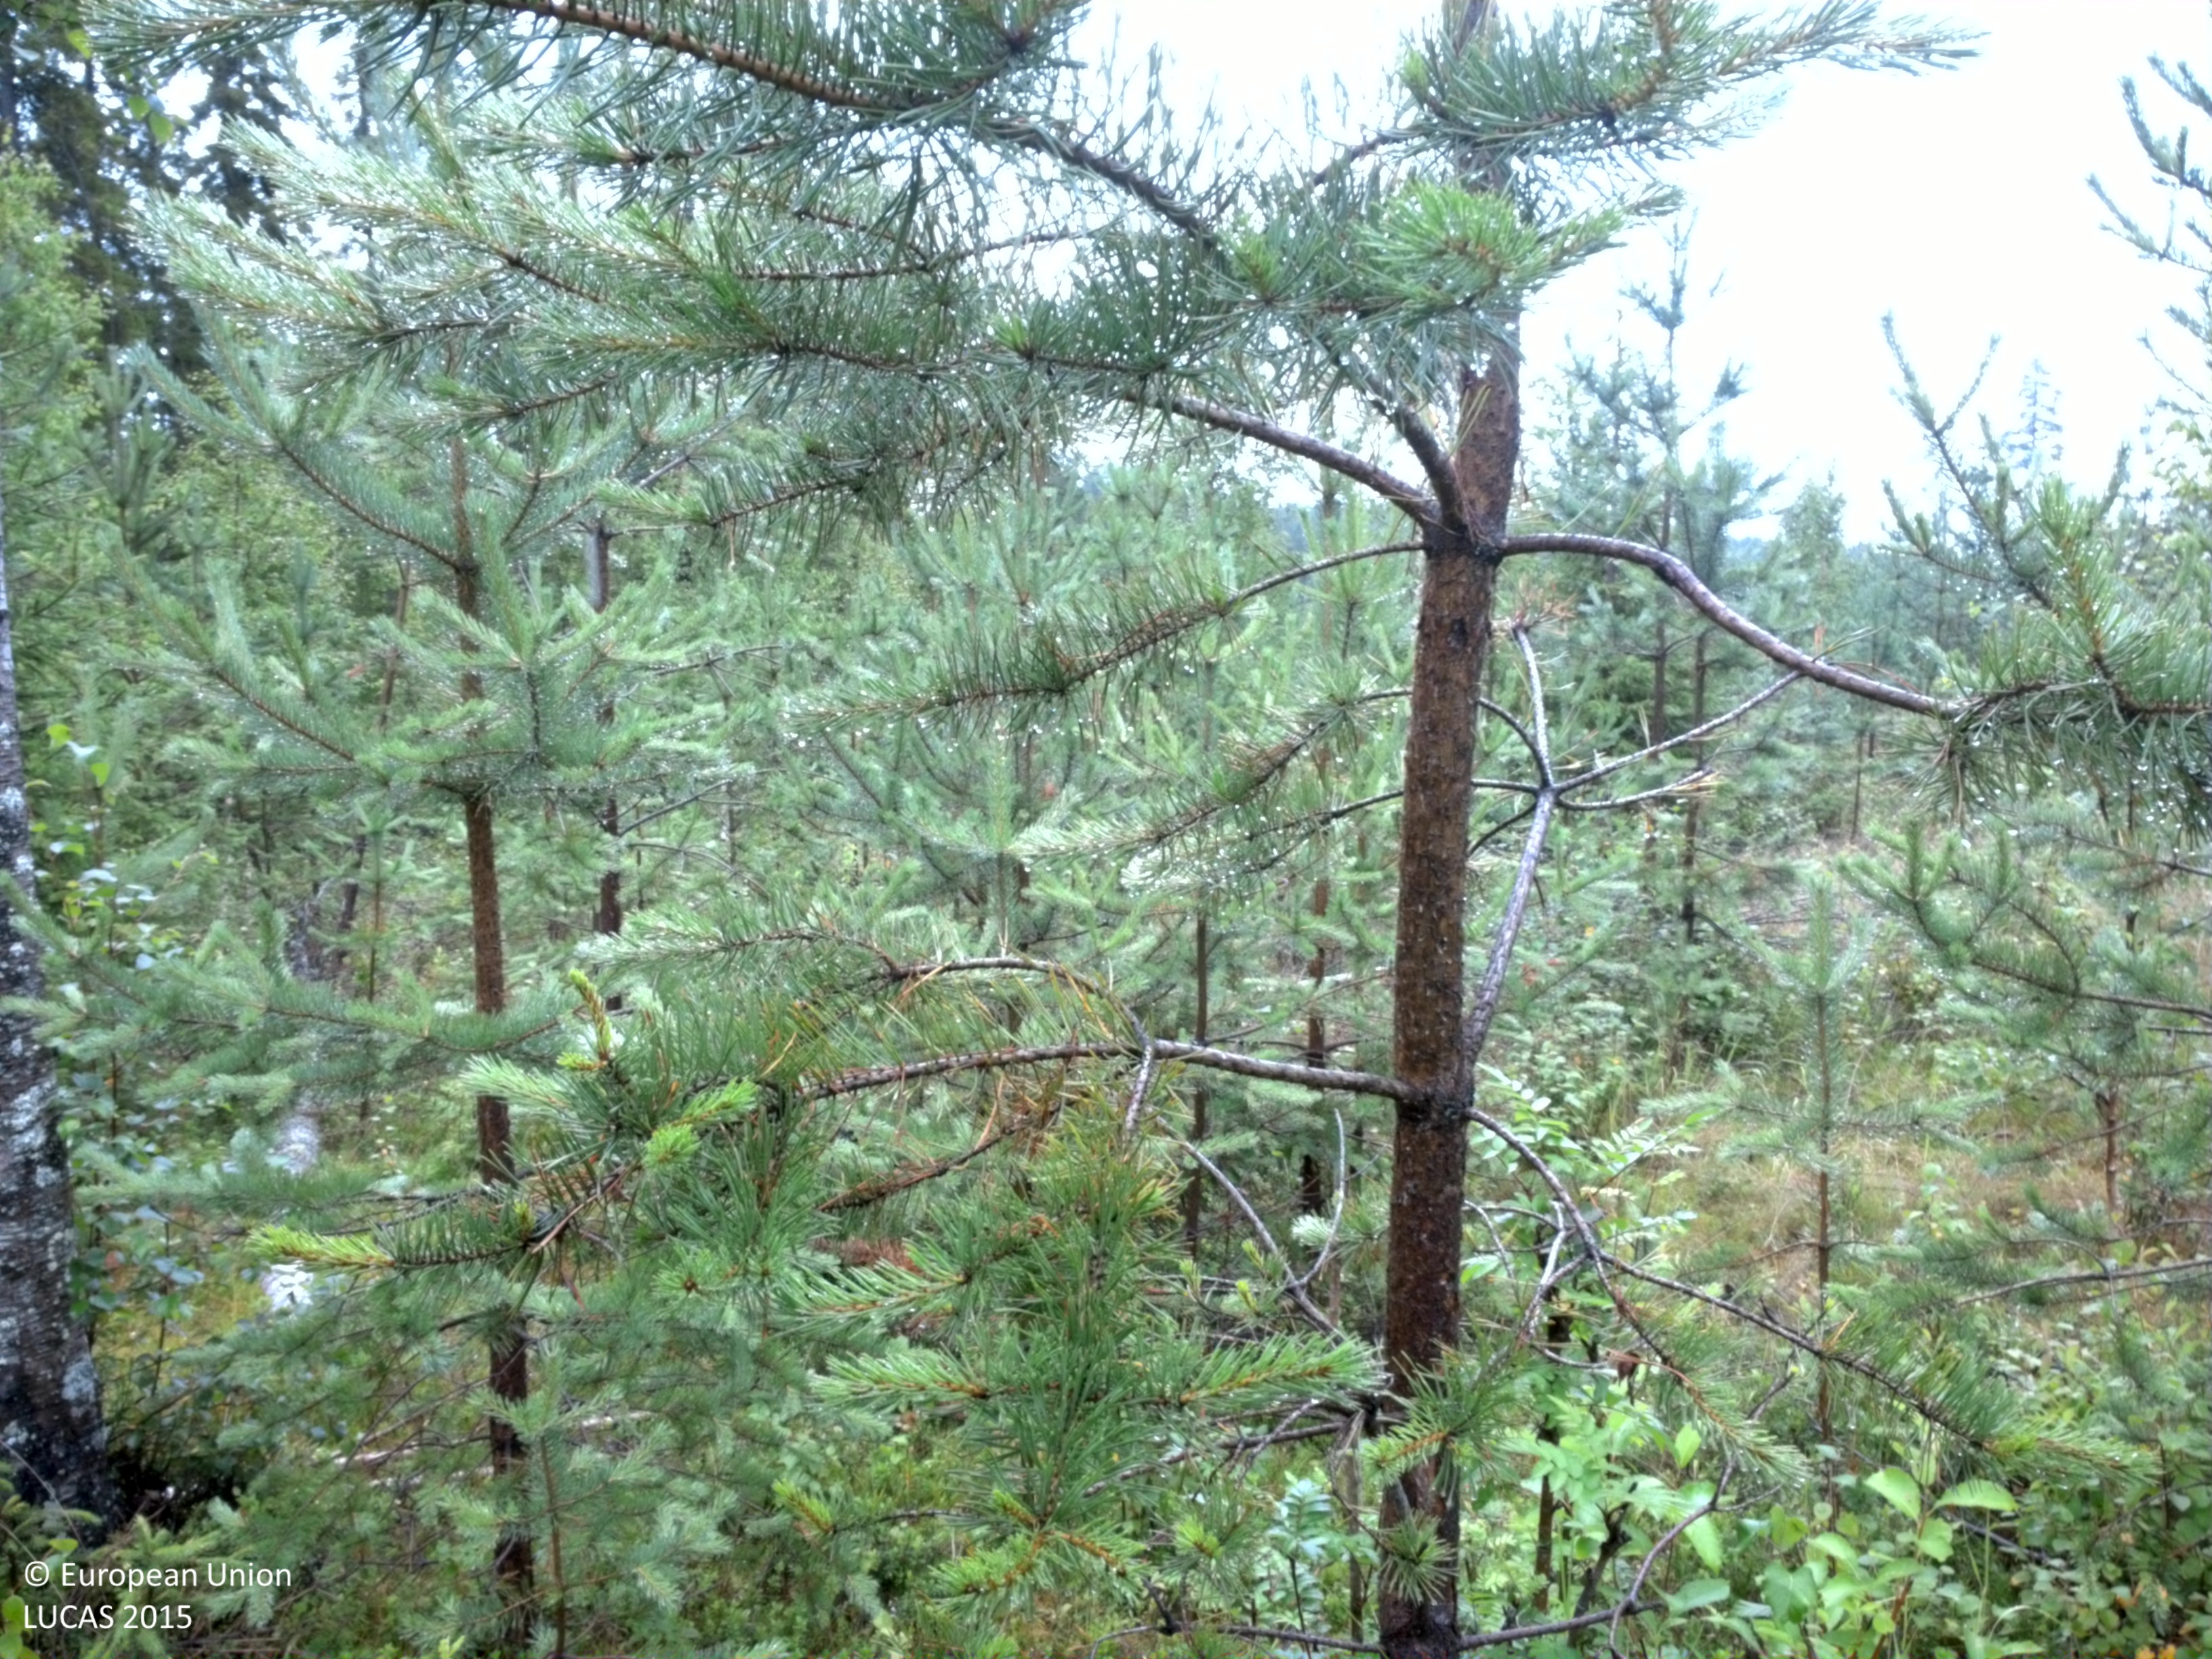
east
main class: Woodland
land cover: Pine dominated mixed woodland
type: boreal forest
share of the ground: 50 - 75 %
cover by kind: coniferous forest trees 45 %, shrubs 25 %, broadleaved forest trees 15 %, herbaceous plants 15 %
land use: Forestry
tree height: > 5 m
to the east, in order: Pine dominated mixed woodland; Spruce dominated coniferous woodland; Broadleaved woodland; Spruce dominated coniferous woodland; Pine dominated coniferous woodland; Inland marshes
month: August
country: SE
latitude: 64.6947
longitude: 20.9446
